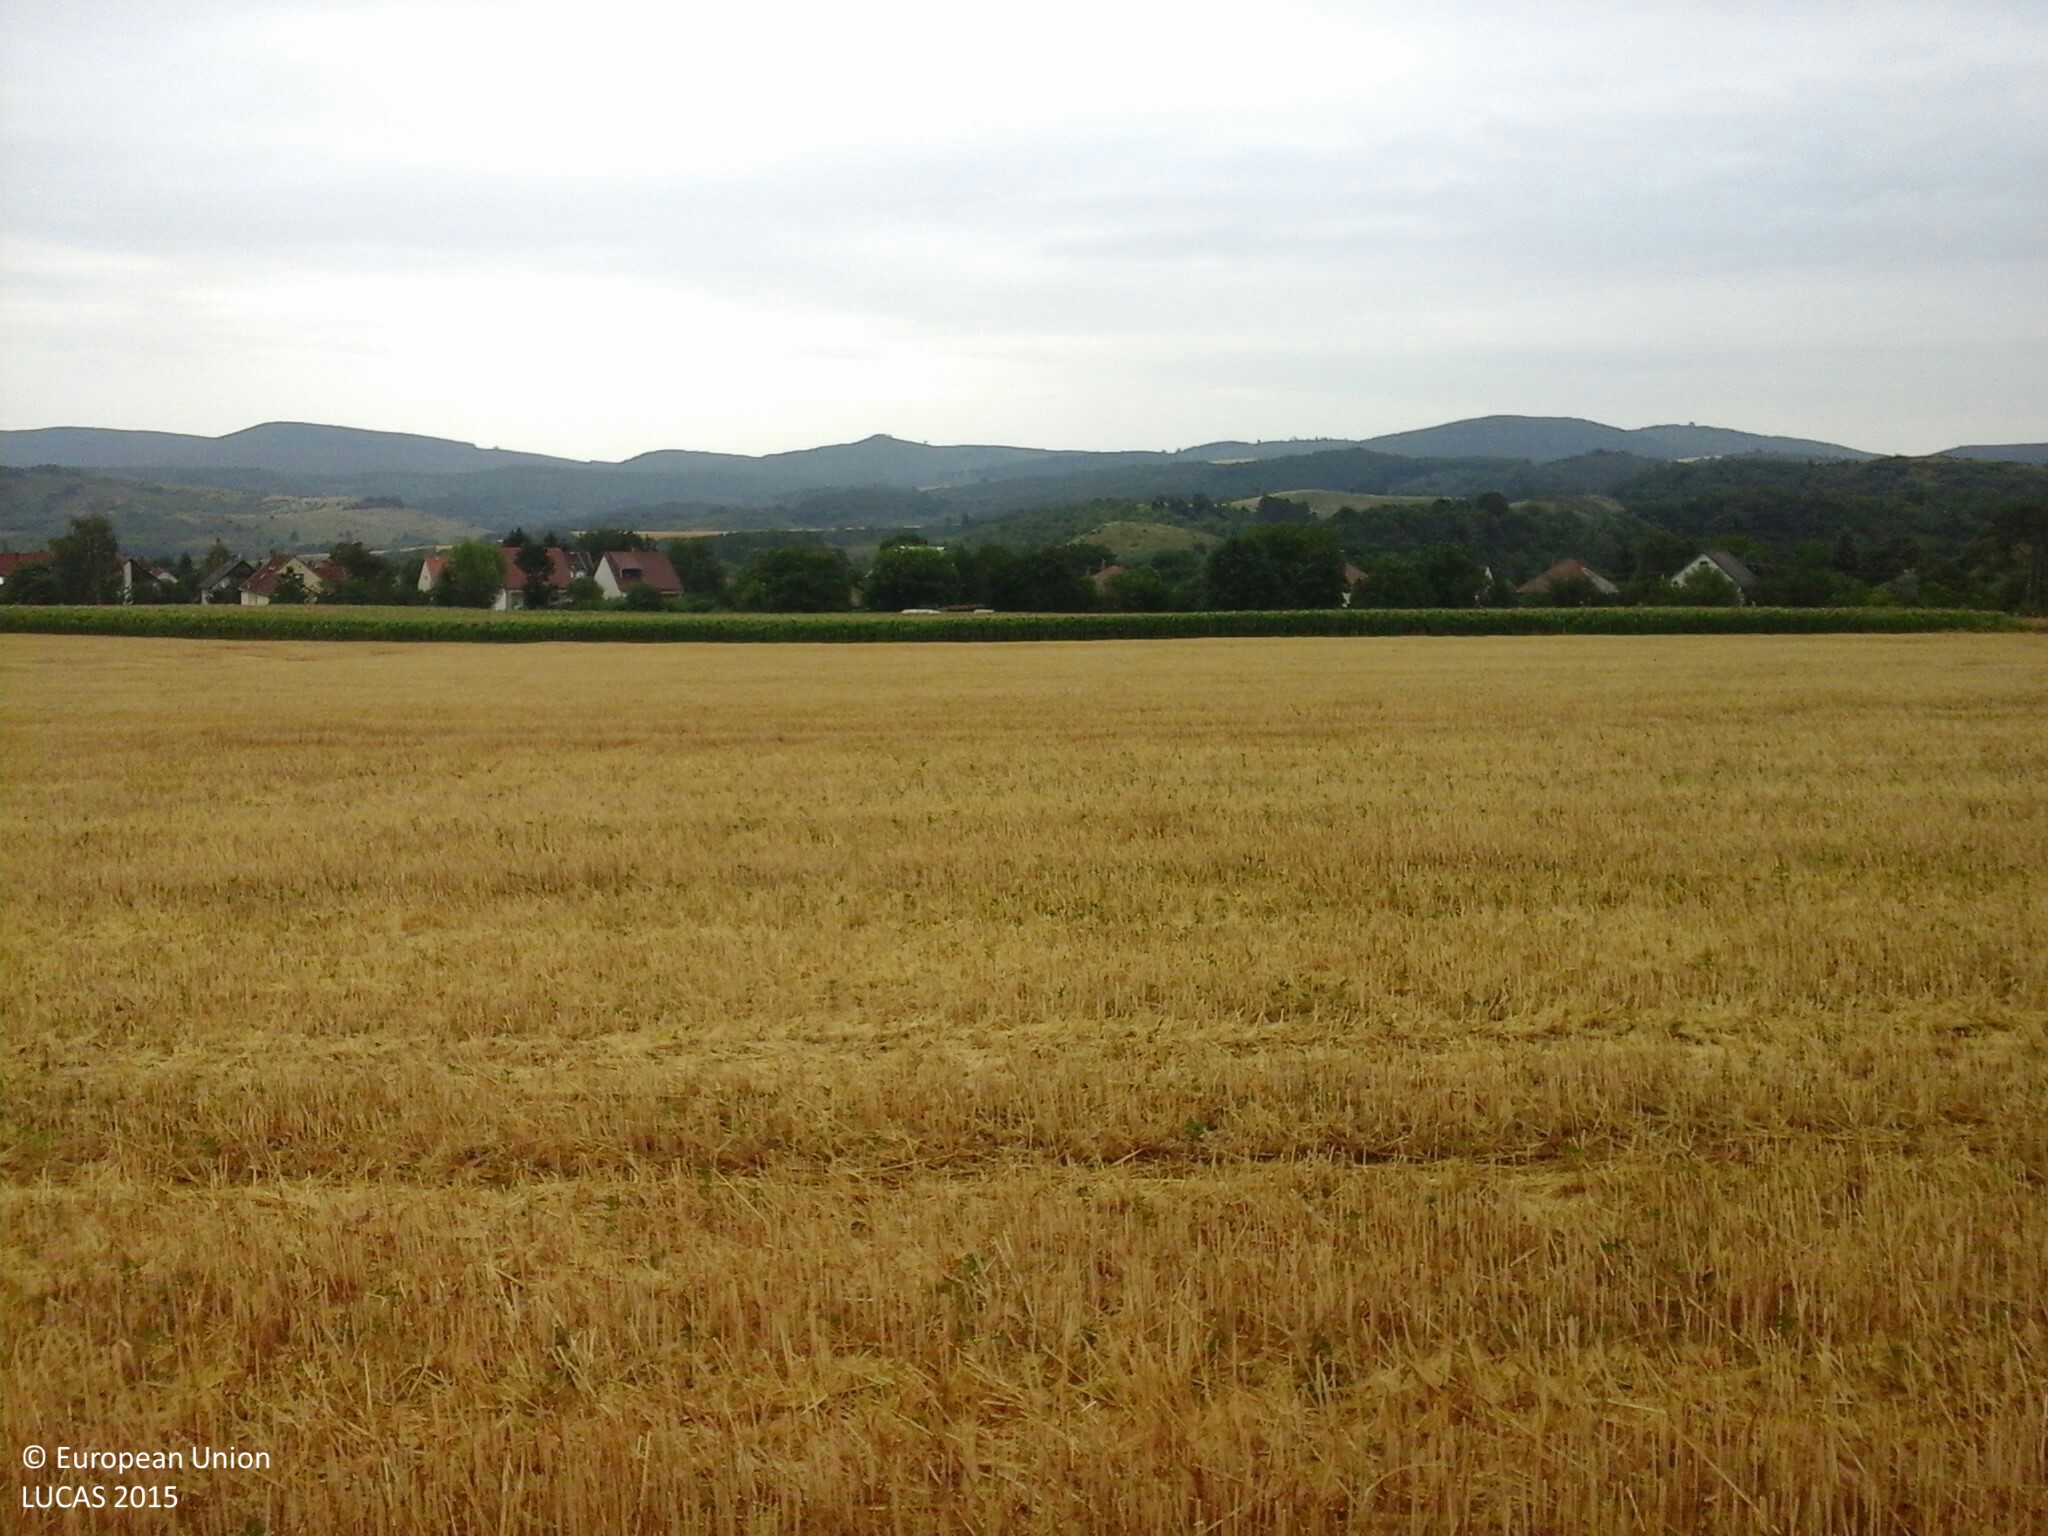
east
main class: Cropland
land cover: Maize
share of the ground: > 75 %
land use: Agriculture (excluding fallow land and kitchen gardens)
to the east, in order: Maize; Common wheat; Maize; Fences; Grass margins; Tracks
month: July
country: HU
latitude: 47.9271
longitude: 19.4313
